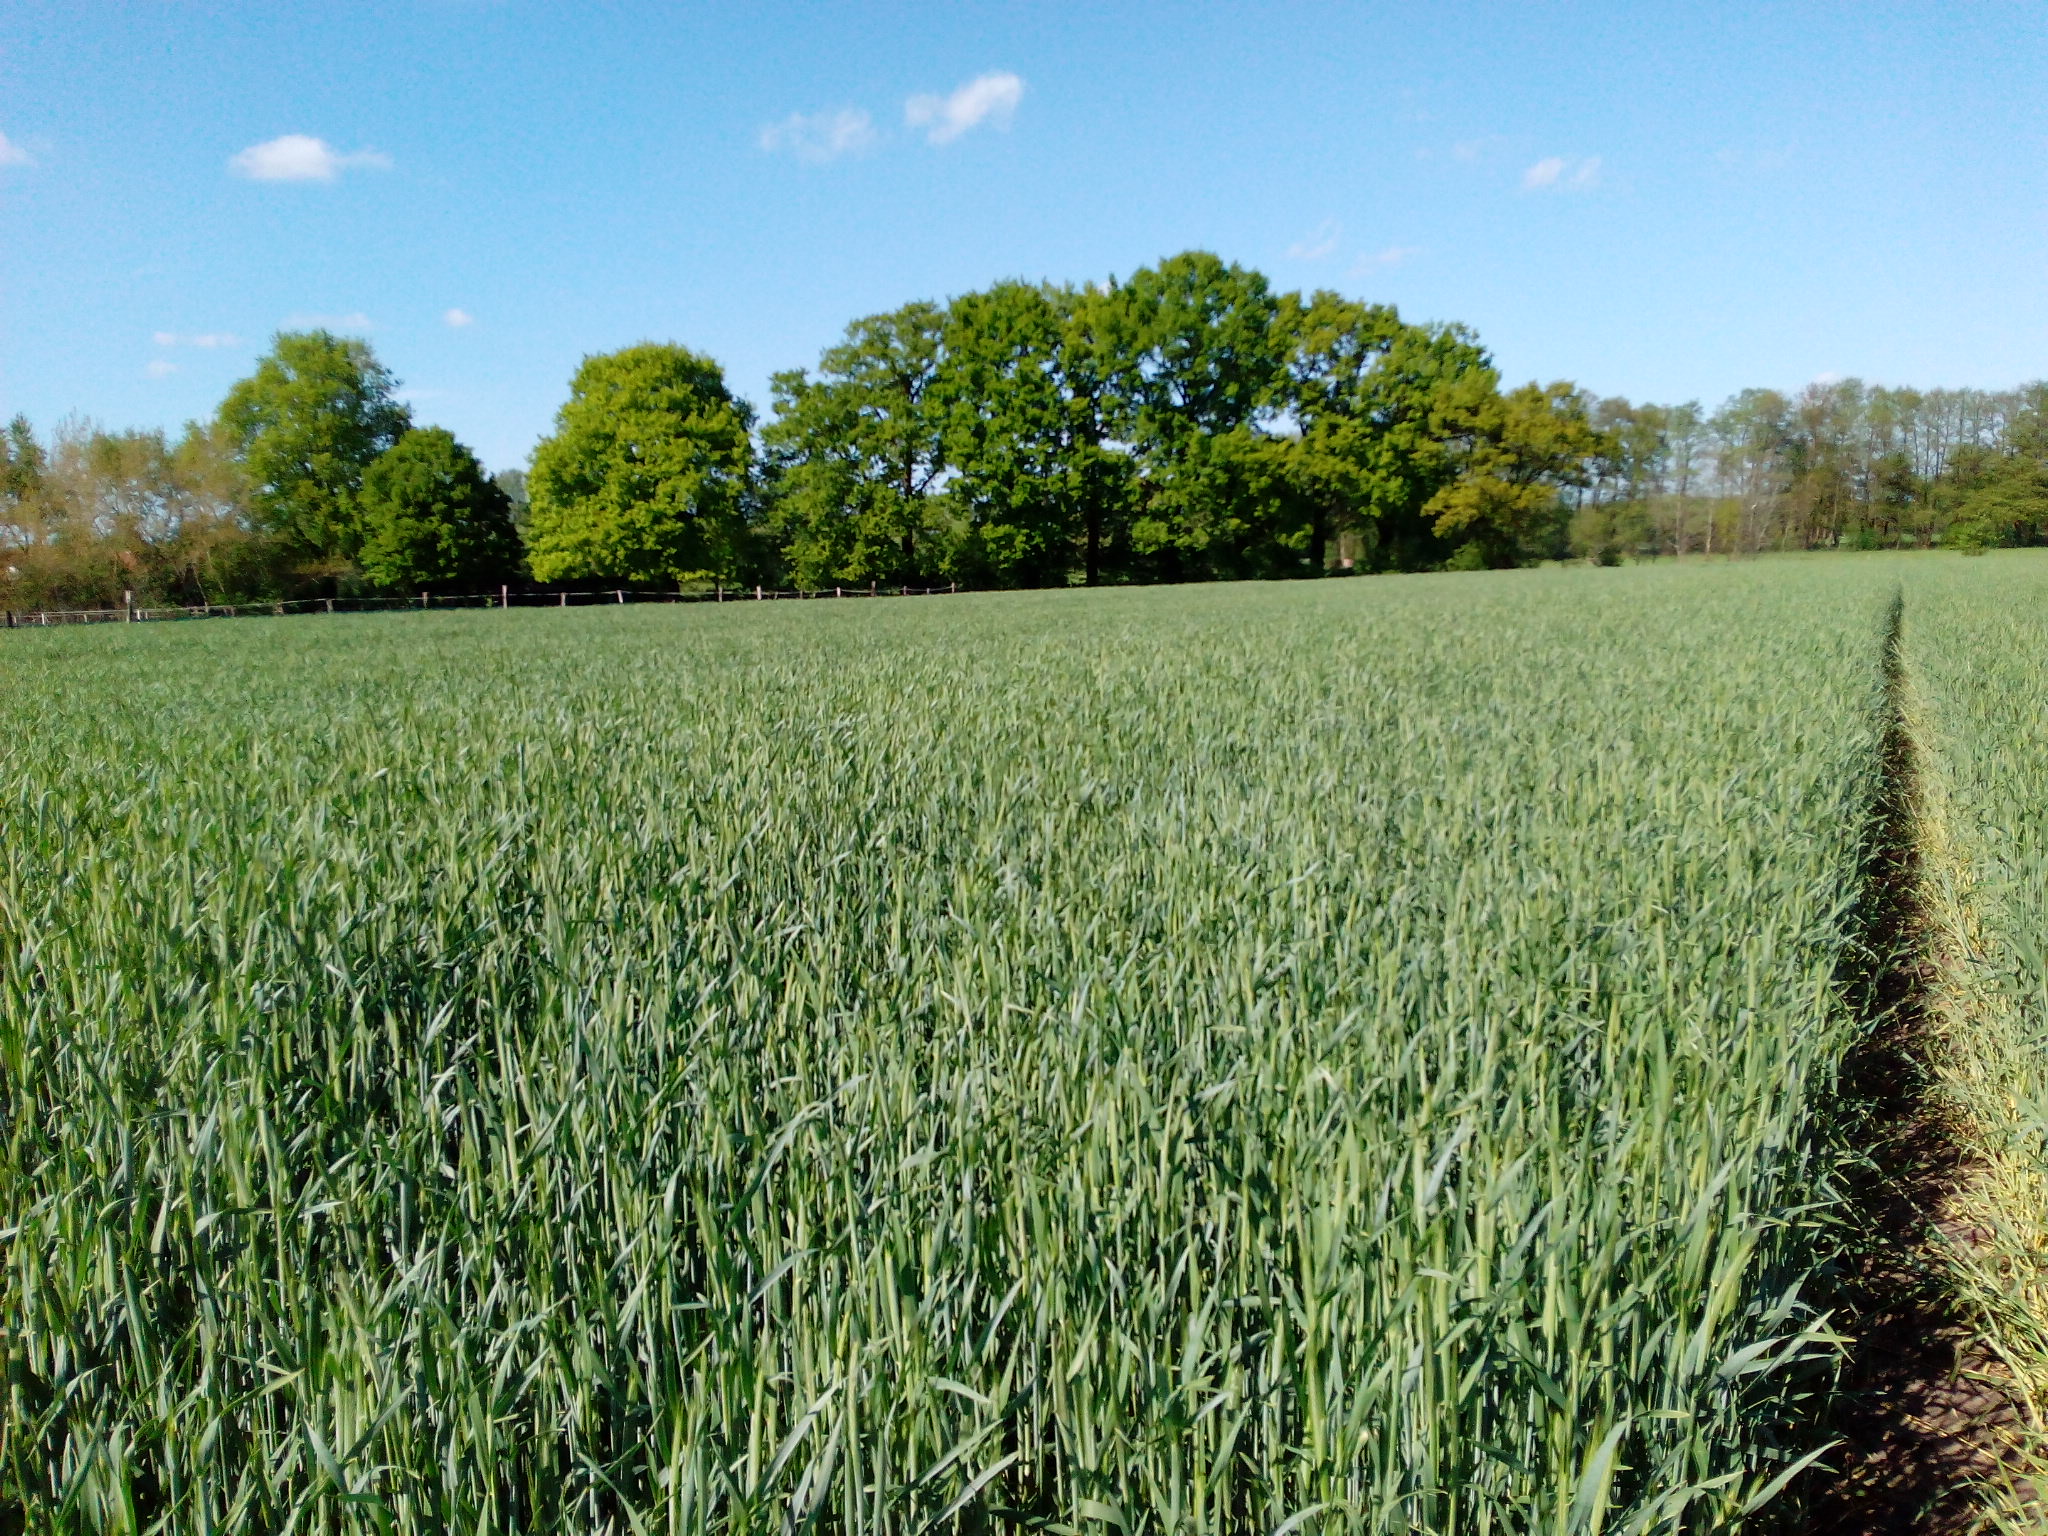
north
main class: Cropland
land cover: Rye
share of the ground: > 75 %
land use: Agriculture (excluding fallow land and kitchen gardens)
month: May
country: DE
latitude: 52.4852
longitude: 9.8675
